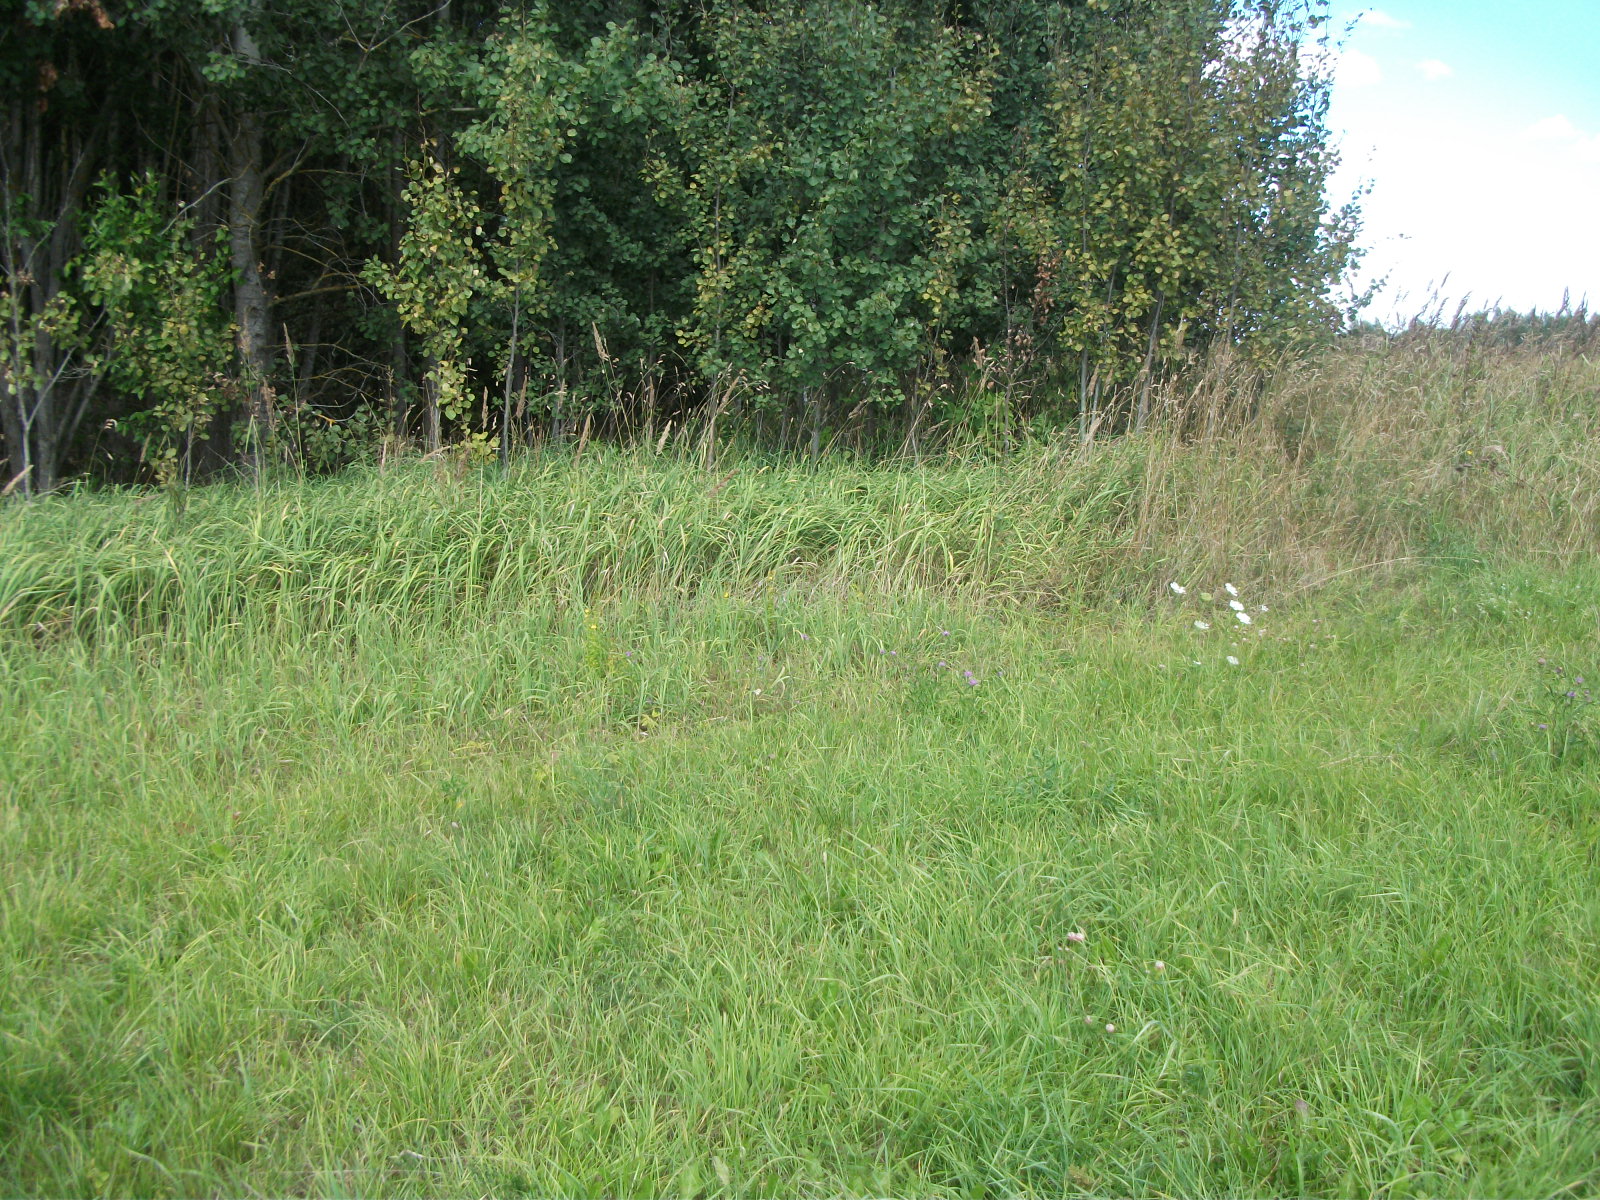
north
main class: Grassland
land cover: Grassland without tree/shrub cover
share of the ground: > 75 %
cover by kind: herbaceous plants 100 %
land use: Agriculture (excluding fallow land and kitchen gardens)
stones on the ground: < 10 %
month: August
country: LV
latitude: 56.5530
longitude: 26.4298
